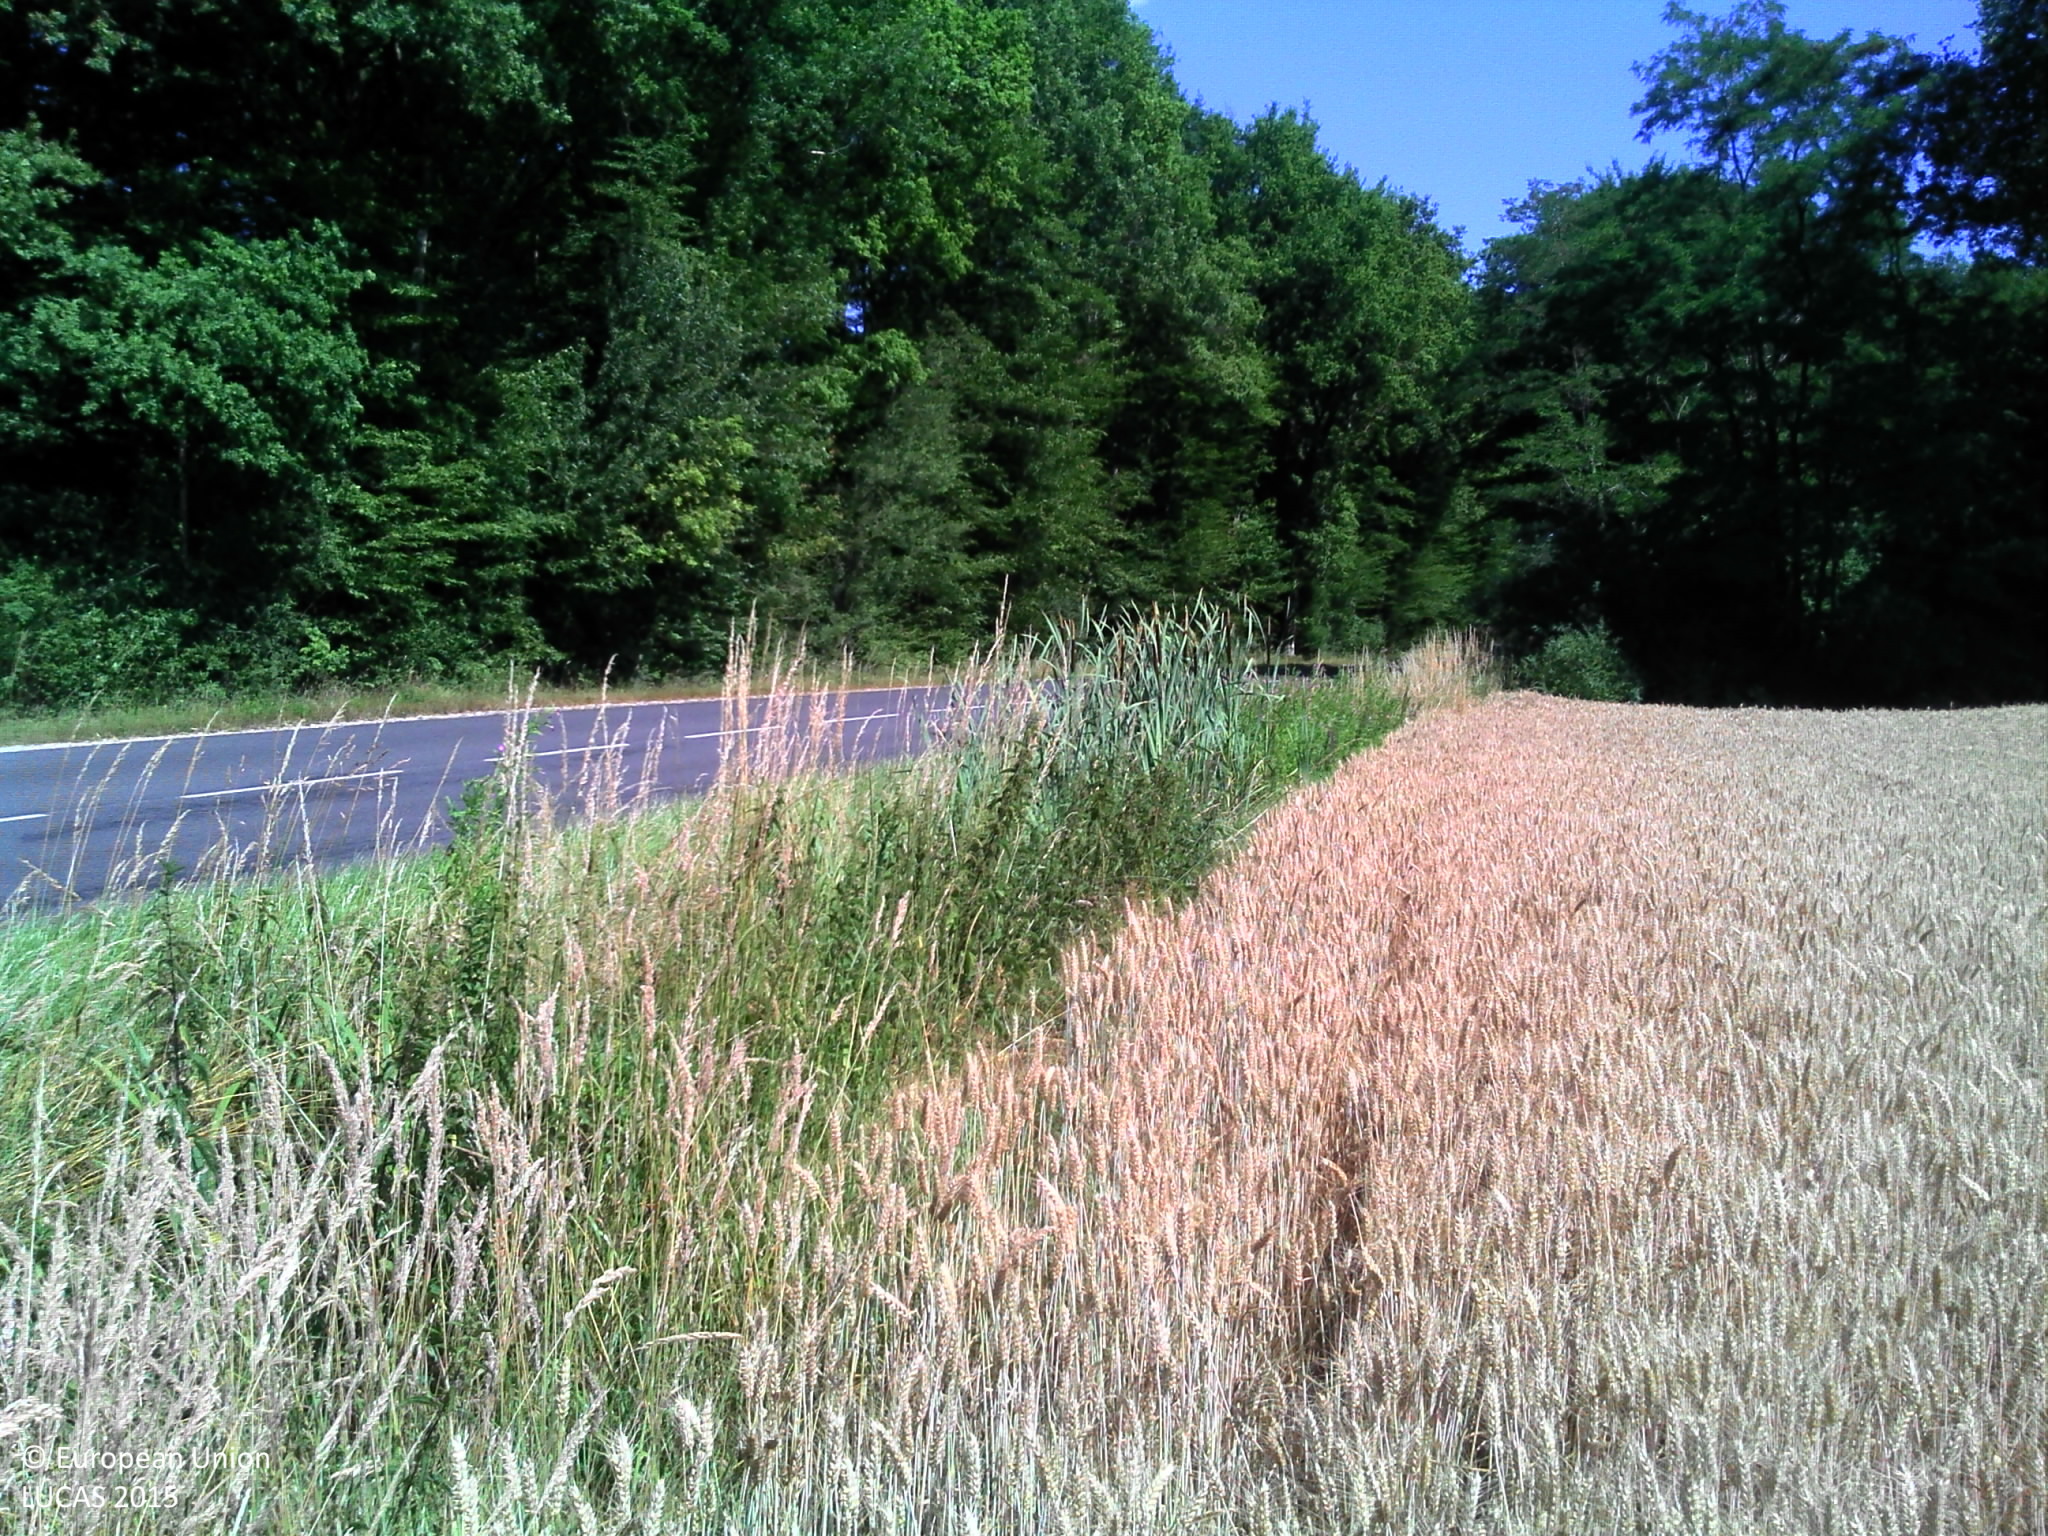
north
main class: Cropland
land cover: Common wheat
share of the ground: > 75 %
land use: Agriculture (excluding fallow land and kitchen gardens)
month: July
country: FR
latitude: 47.9871
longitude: 3.0658
